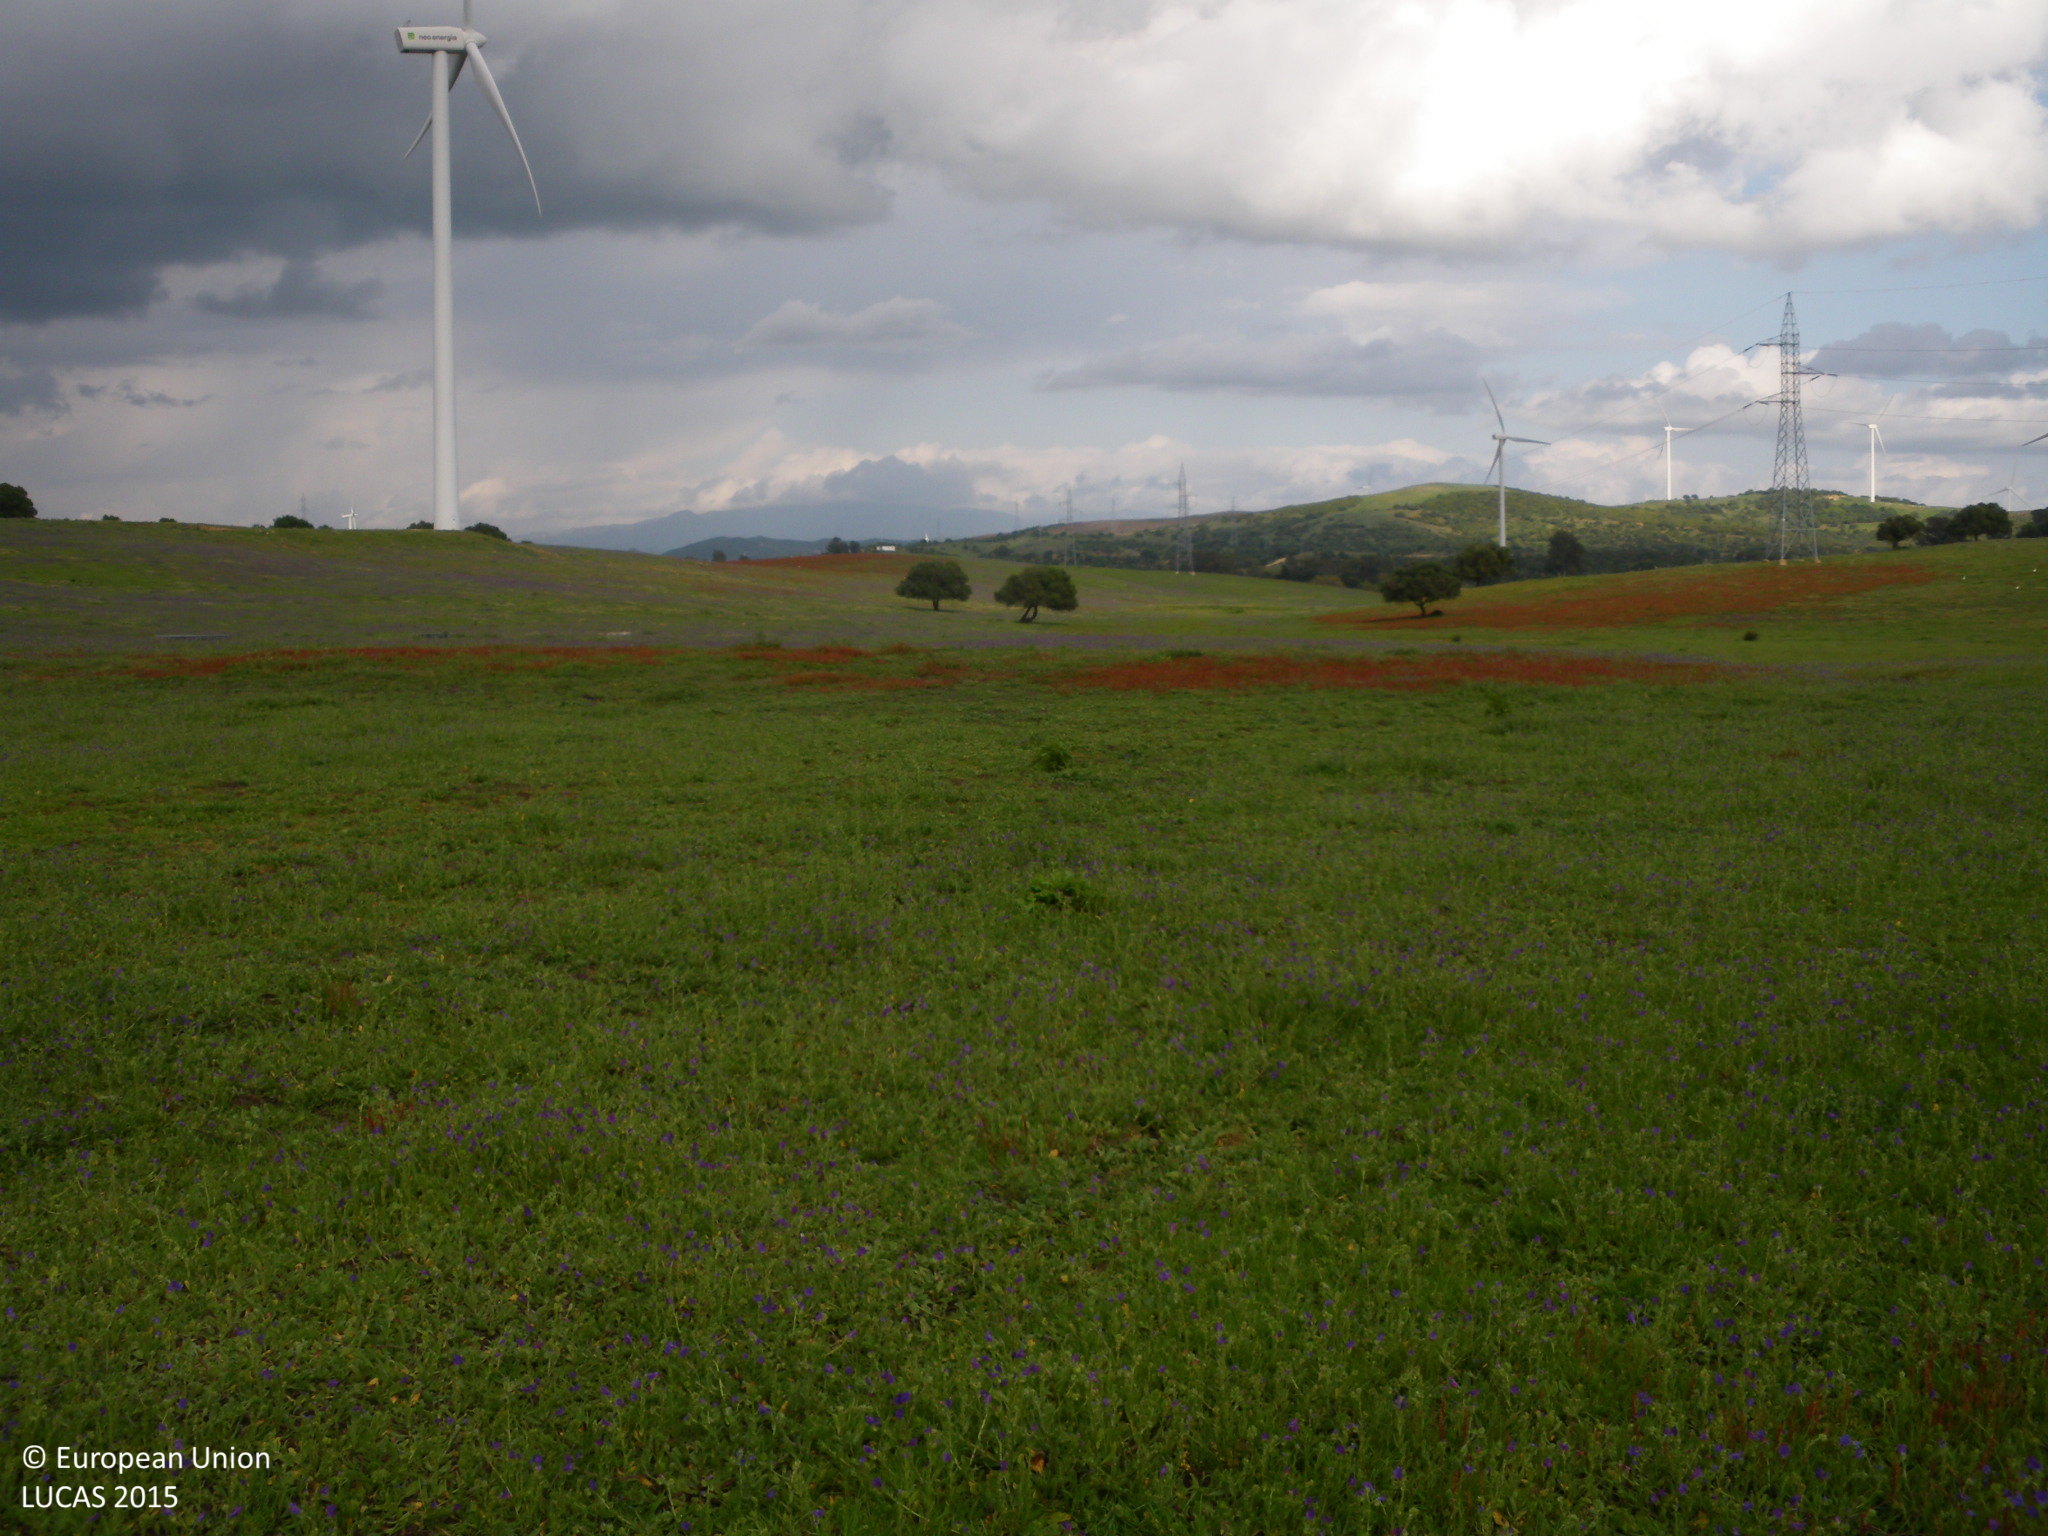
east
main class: Grassland
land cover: Spontaneously vegetated surfaces
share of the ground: > 75 %
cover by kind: herbaceous plants 100 %
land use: Agriculture (excluding fallow land and kitchen gardens)
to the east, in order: Spontaneously vegetated surfaces; Single bushes/trees; Spontaneously vegetated surfaces
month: April
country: ES
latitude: 36.4906
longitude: -5.9121
